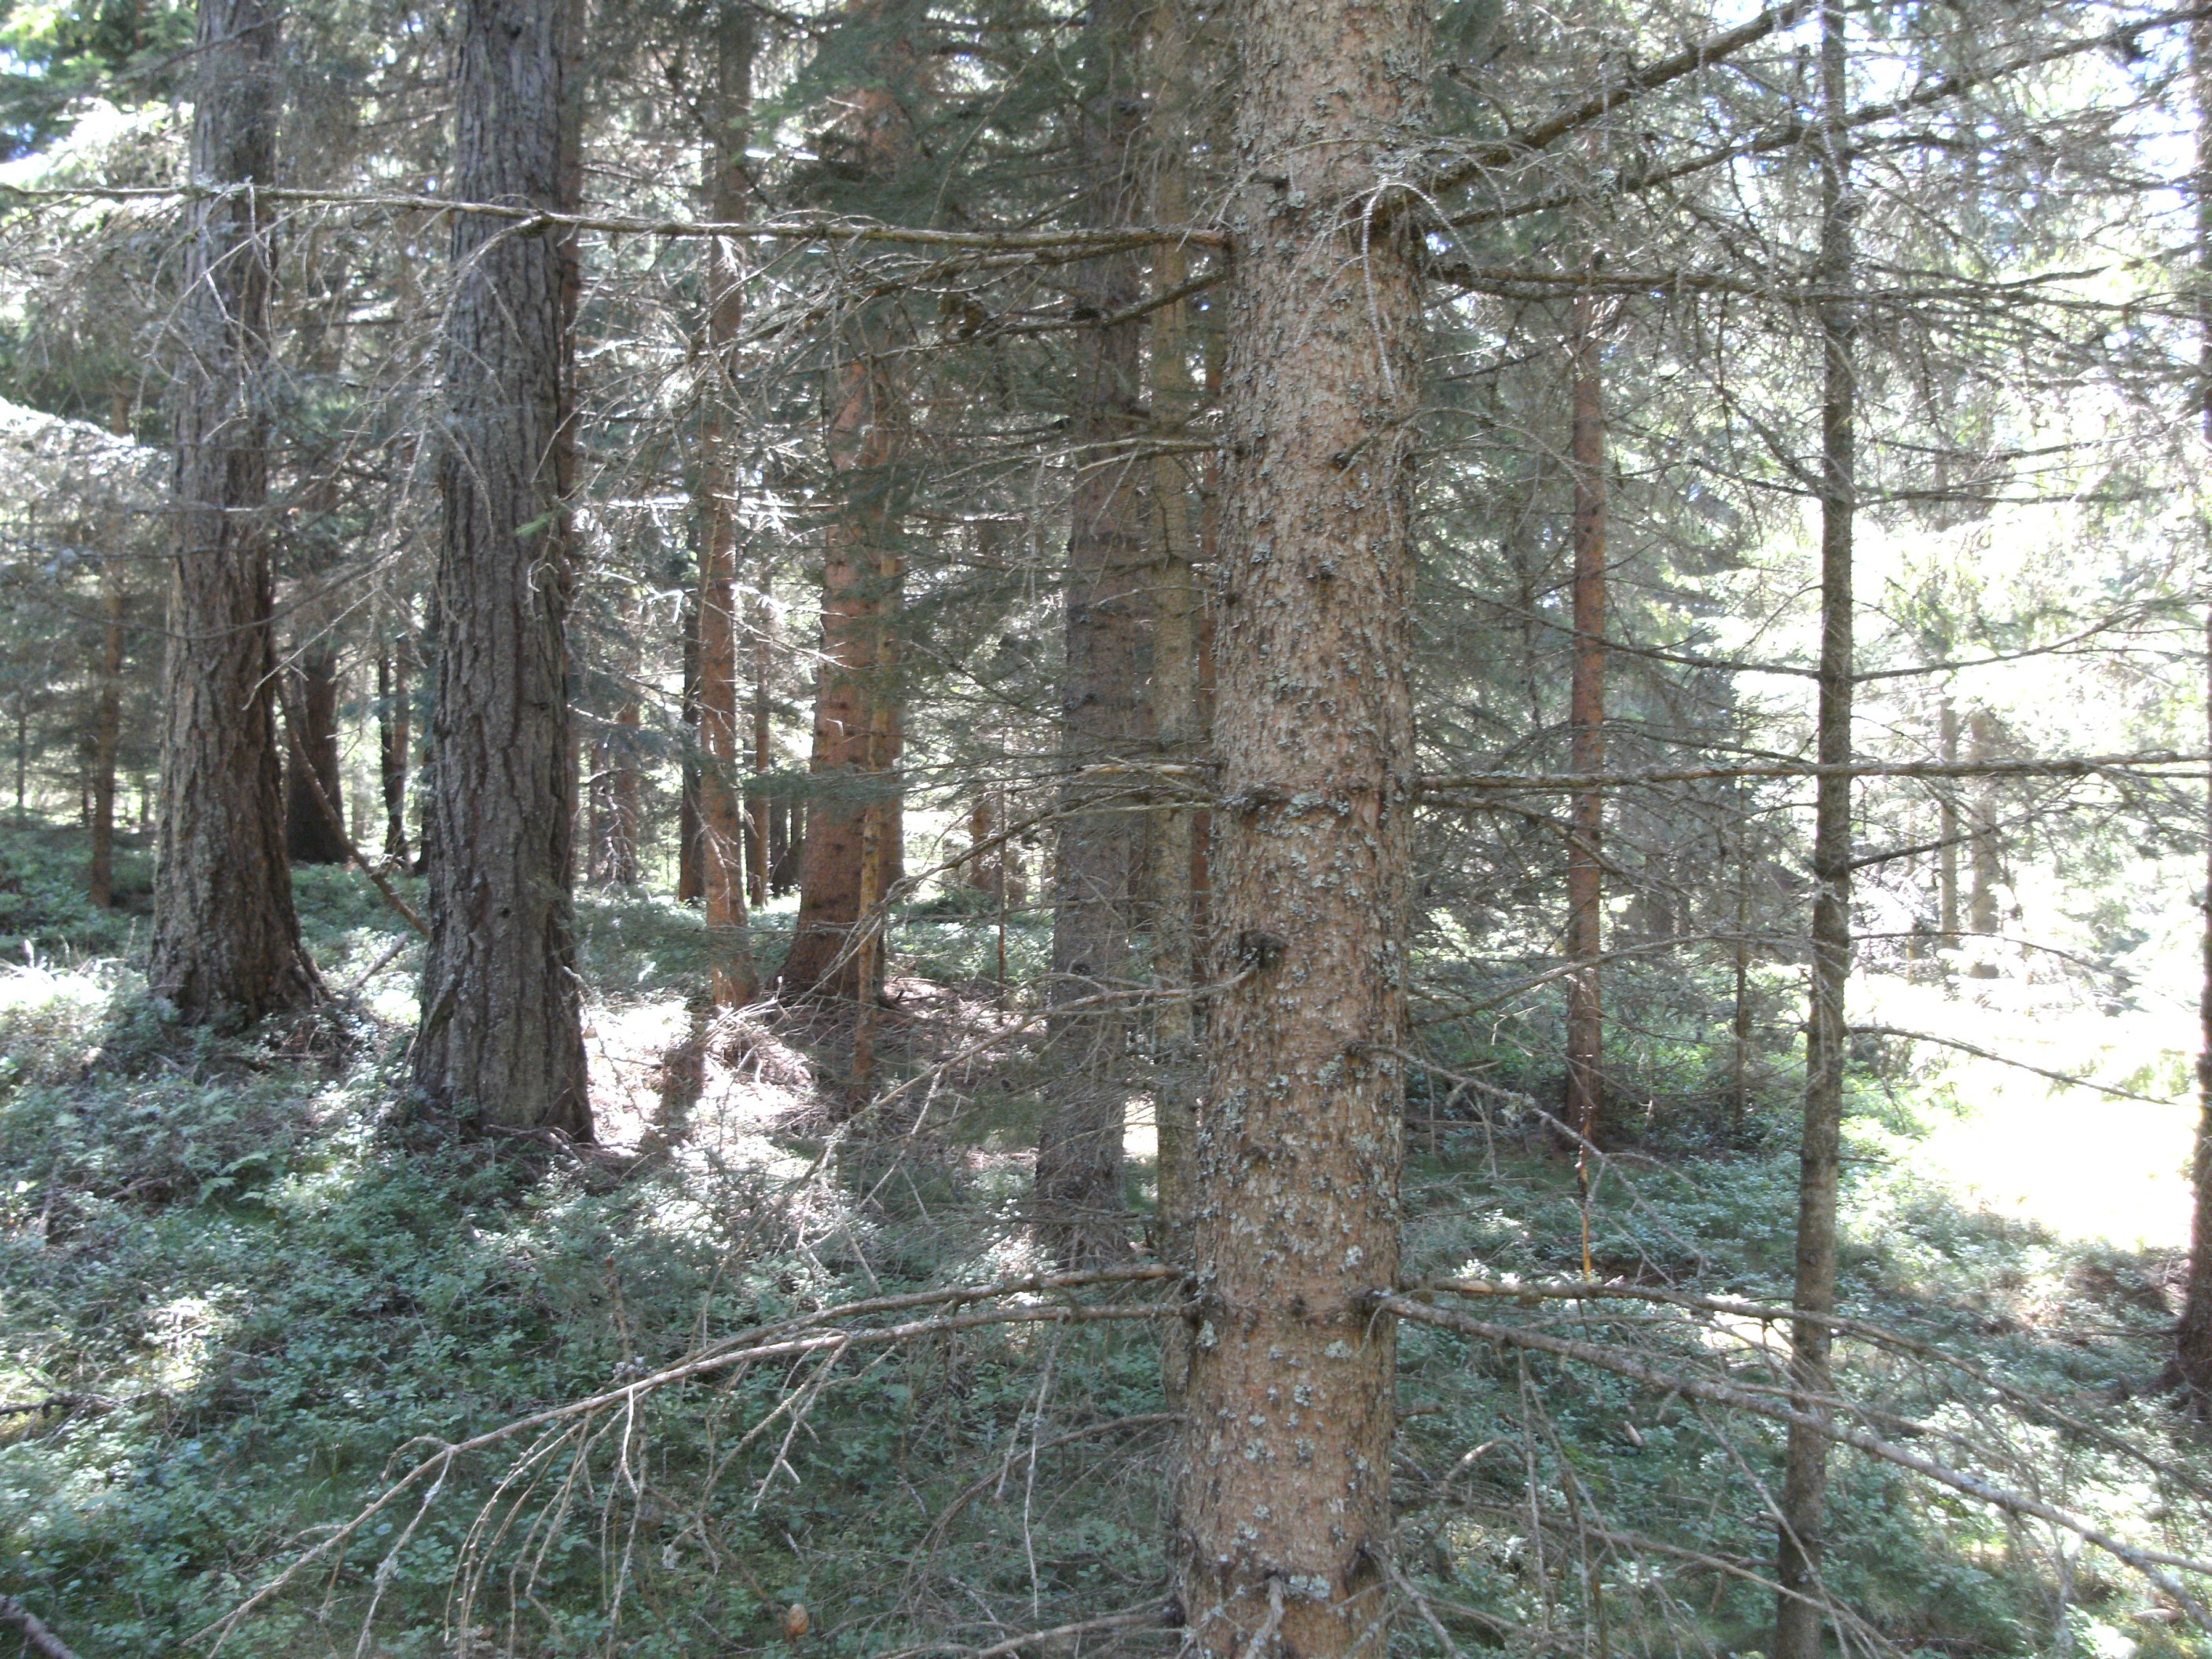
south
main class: Woodland
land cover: Spruce dominated coniferous woodland
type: alpine coniferous forest
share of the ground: 50 - 75 %
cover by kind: coniferous forest trees 75 %, shrubs 15 %, herbaceous plants 10 %
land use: Forestry
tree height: > 5 m
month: July
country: AT
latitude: 46.9043
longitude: 14.9478
